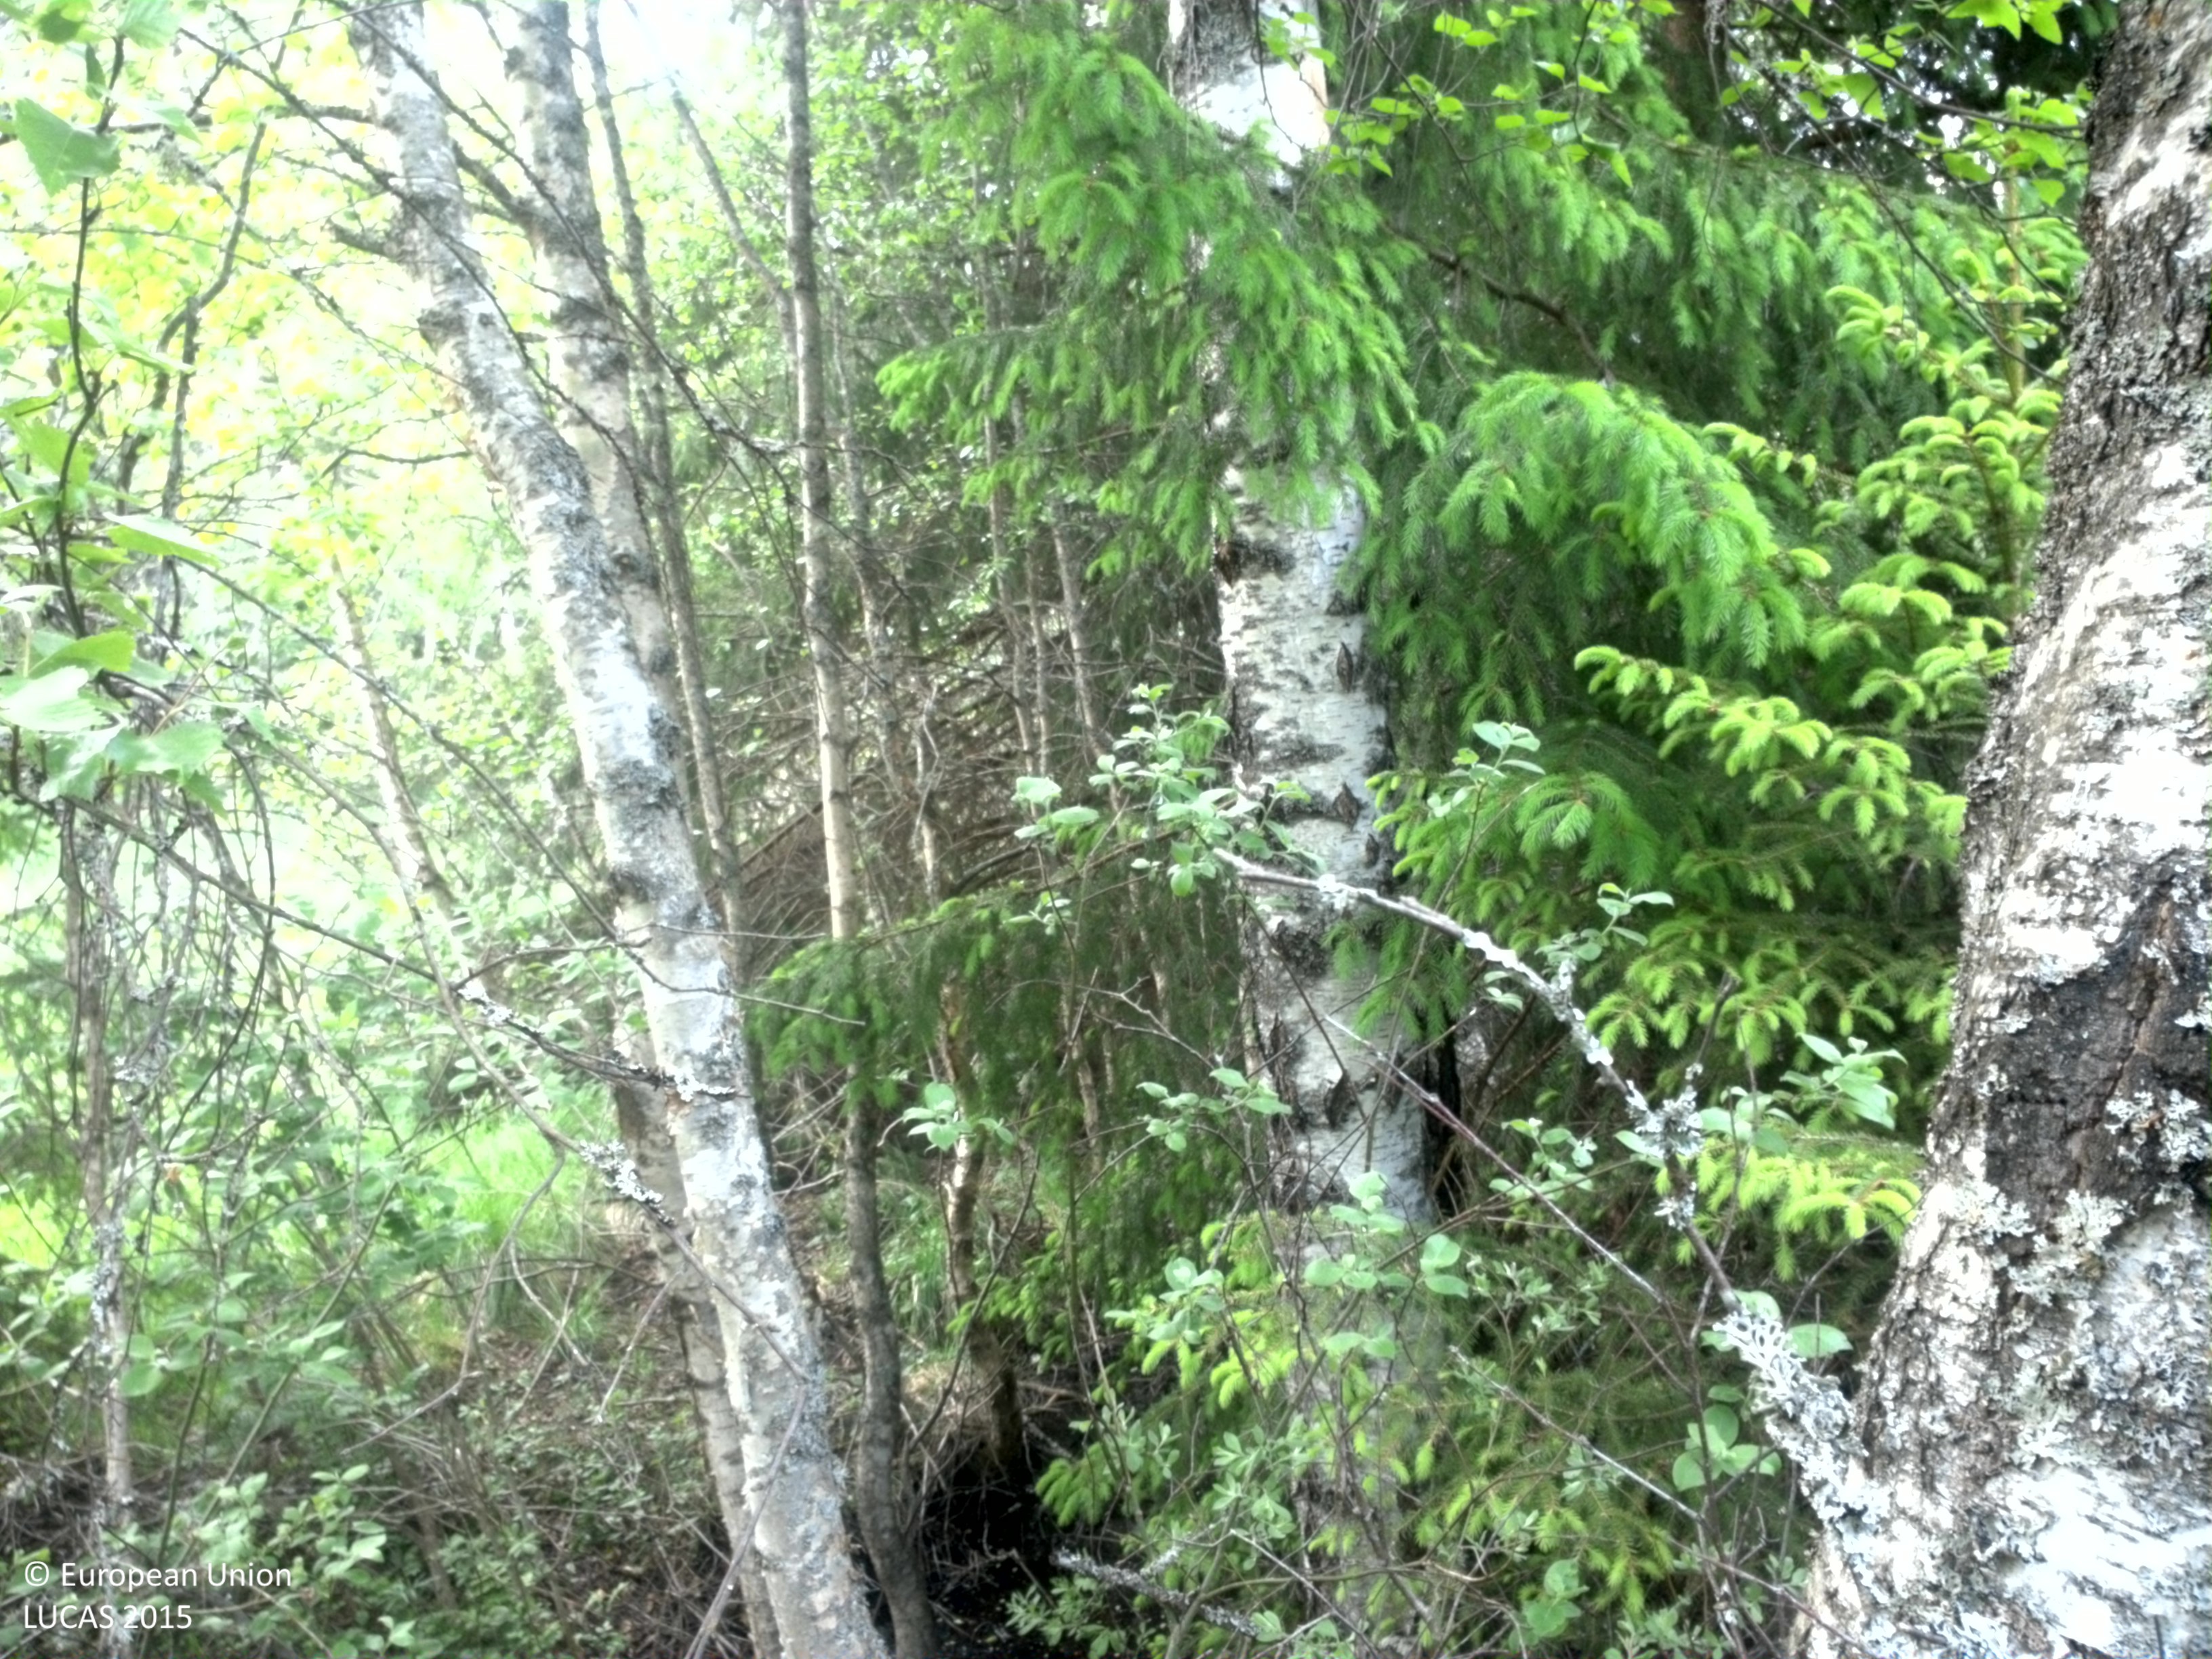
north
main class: Woodland
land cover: Broadleaved woodland
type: boreal forest
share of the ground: 50 - 75 %
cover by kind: broadleaved forest trees 50 %, herbaceous plants 15 %, lichens and mosses 15 %, coniferous forest trees 10 %, shrubs 10 %
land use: Forestry
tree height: > 5 m
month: May
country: SE
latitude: 57.3132
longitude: 15.9252
